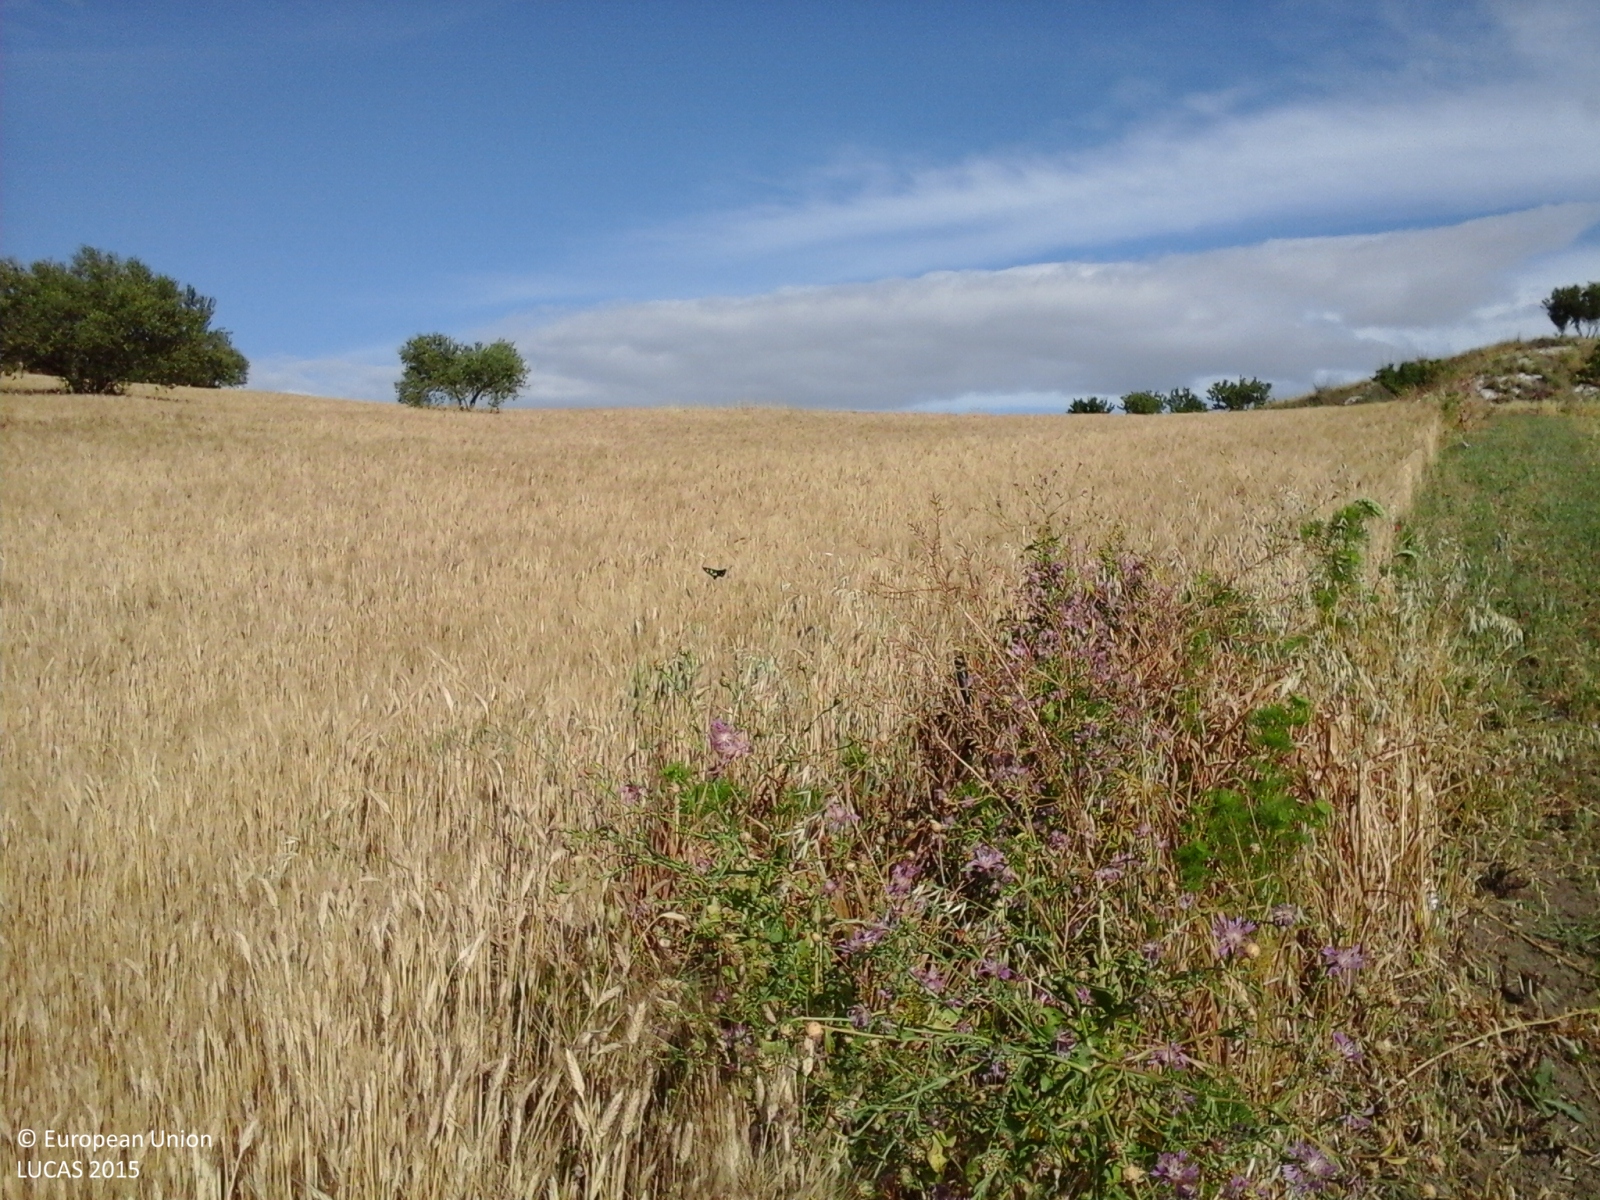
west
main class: Cropland
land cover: Durum wheat
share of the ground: > 75 %
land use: Agriculture (excluding fallow land and kitchen gardens)
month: June
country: IT
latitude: 37.5720
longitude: 14.0124
